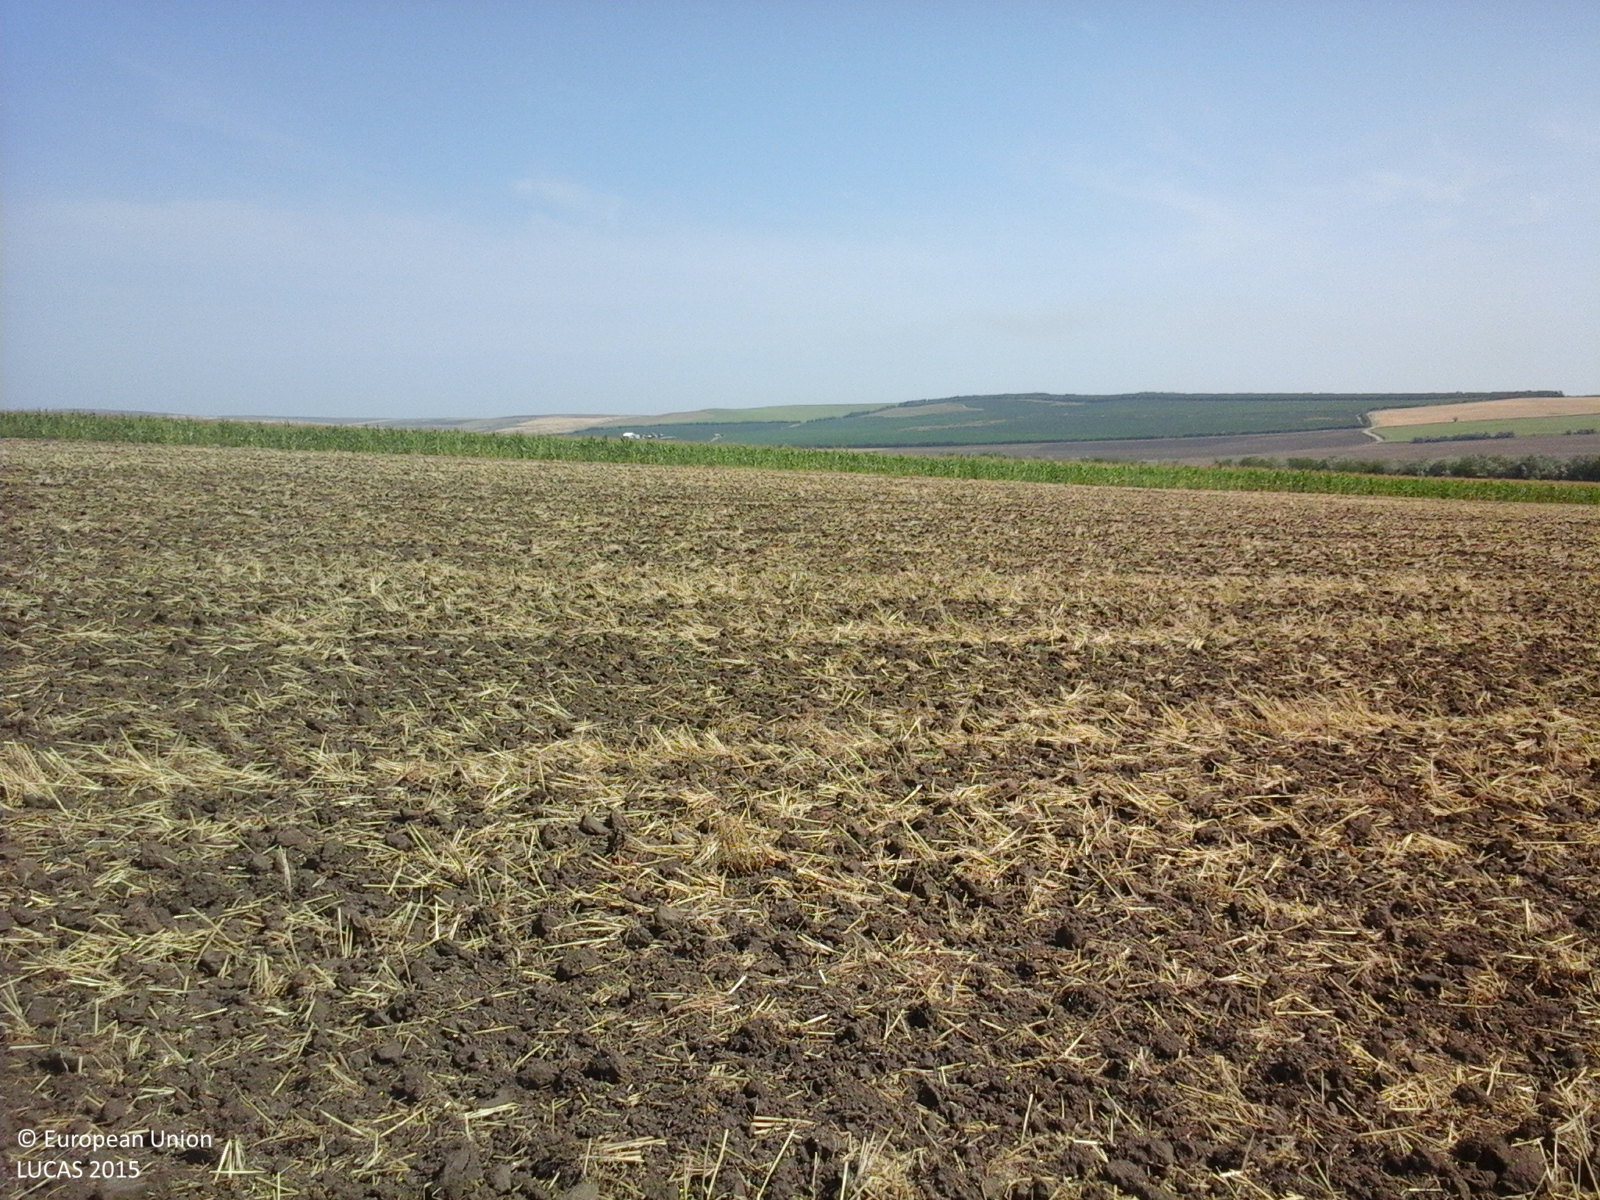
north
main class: Cropland
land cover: Common wheat
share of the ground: 10 - 25 %
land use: Agriculture (excluding fallow land and kitchen gardens)
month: July
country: RO
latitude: 46.3051
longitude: 28.0844
